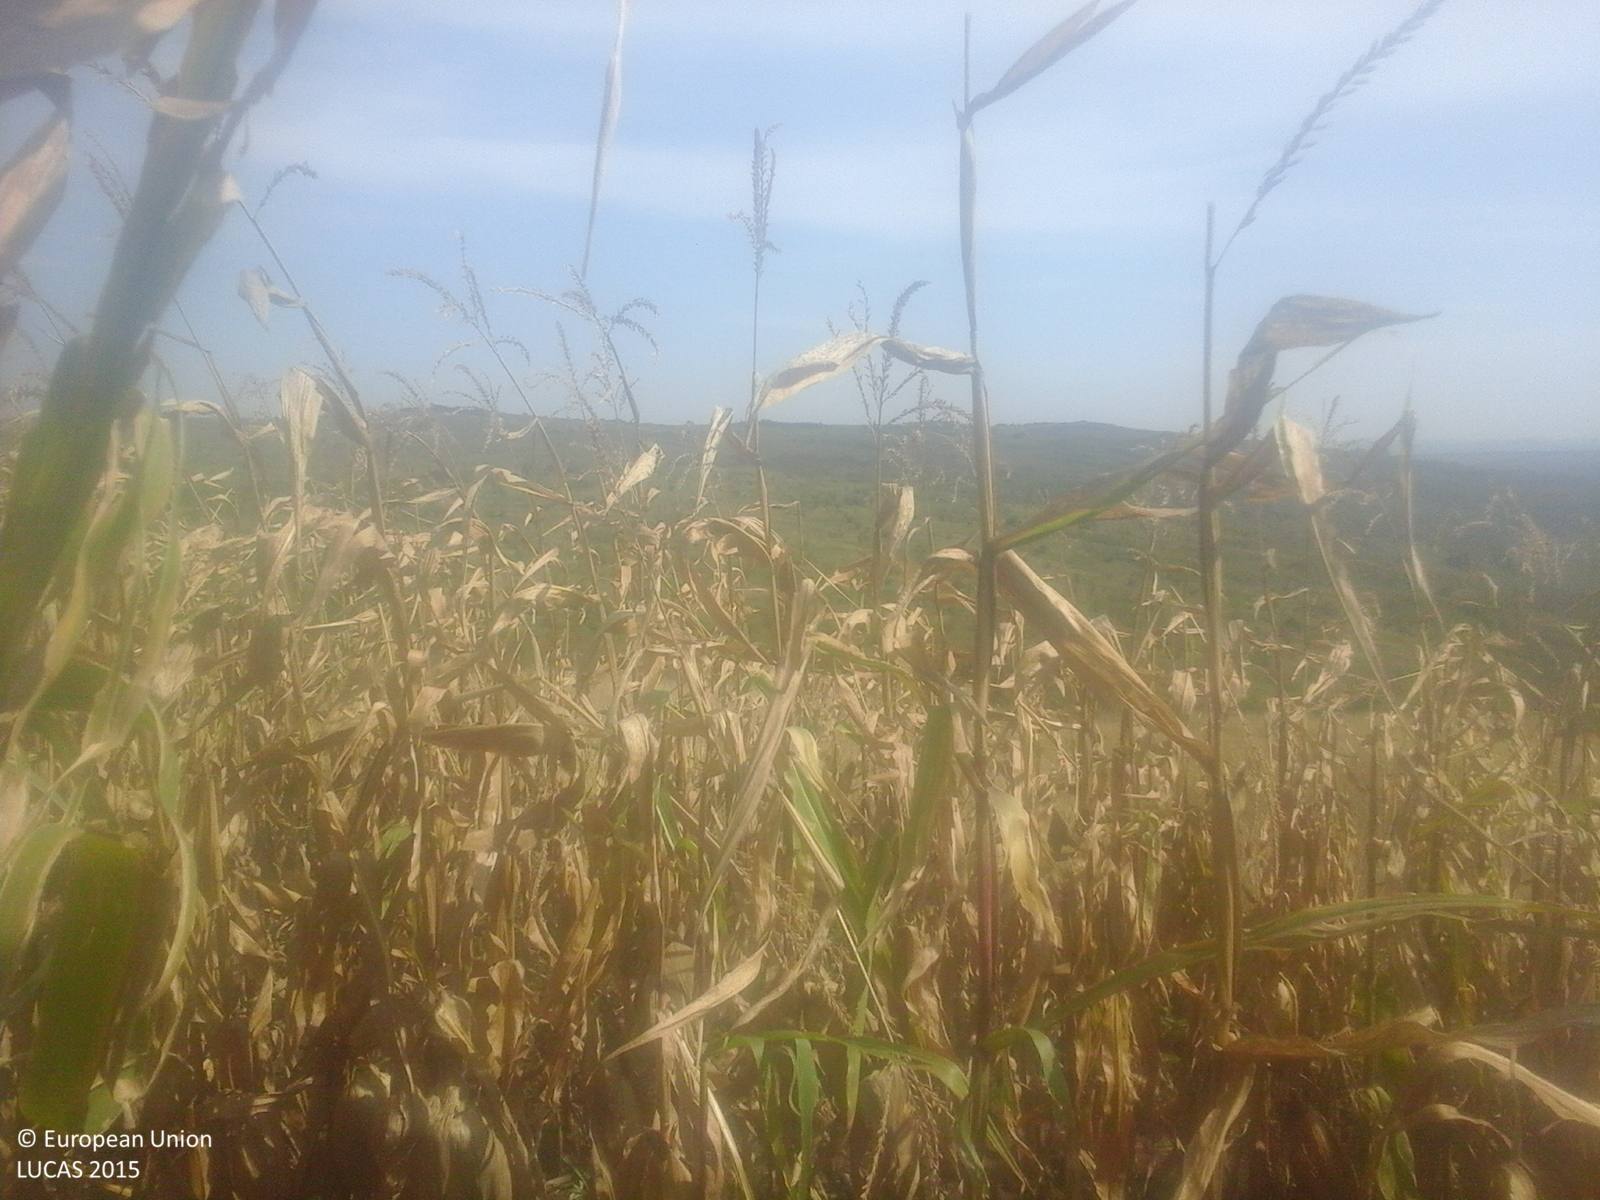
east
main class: Cropland
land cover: Maize
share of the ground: > 75 %
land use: Agriculture (excluding fallow land and kitchen gardens)
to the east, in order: Maize; Grassland with sparse tree/shrub cover; Shrubland without tree cover
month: September
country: RO
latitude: 46.9614
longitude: 23.7022
